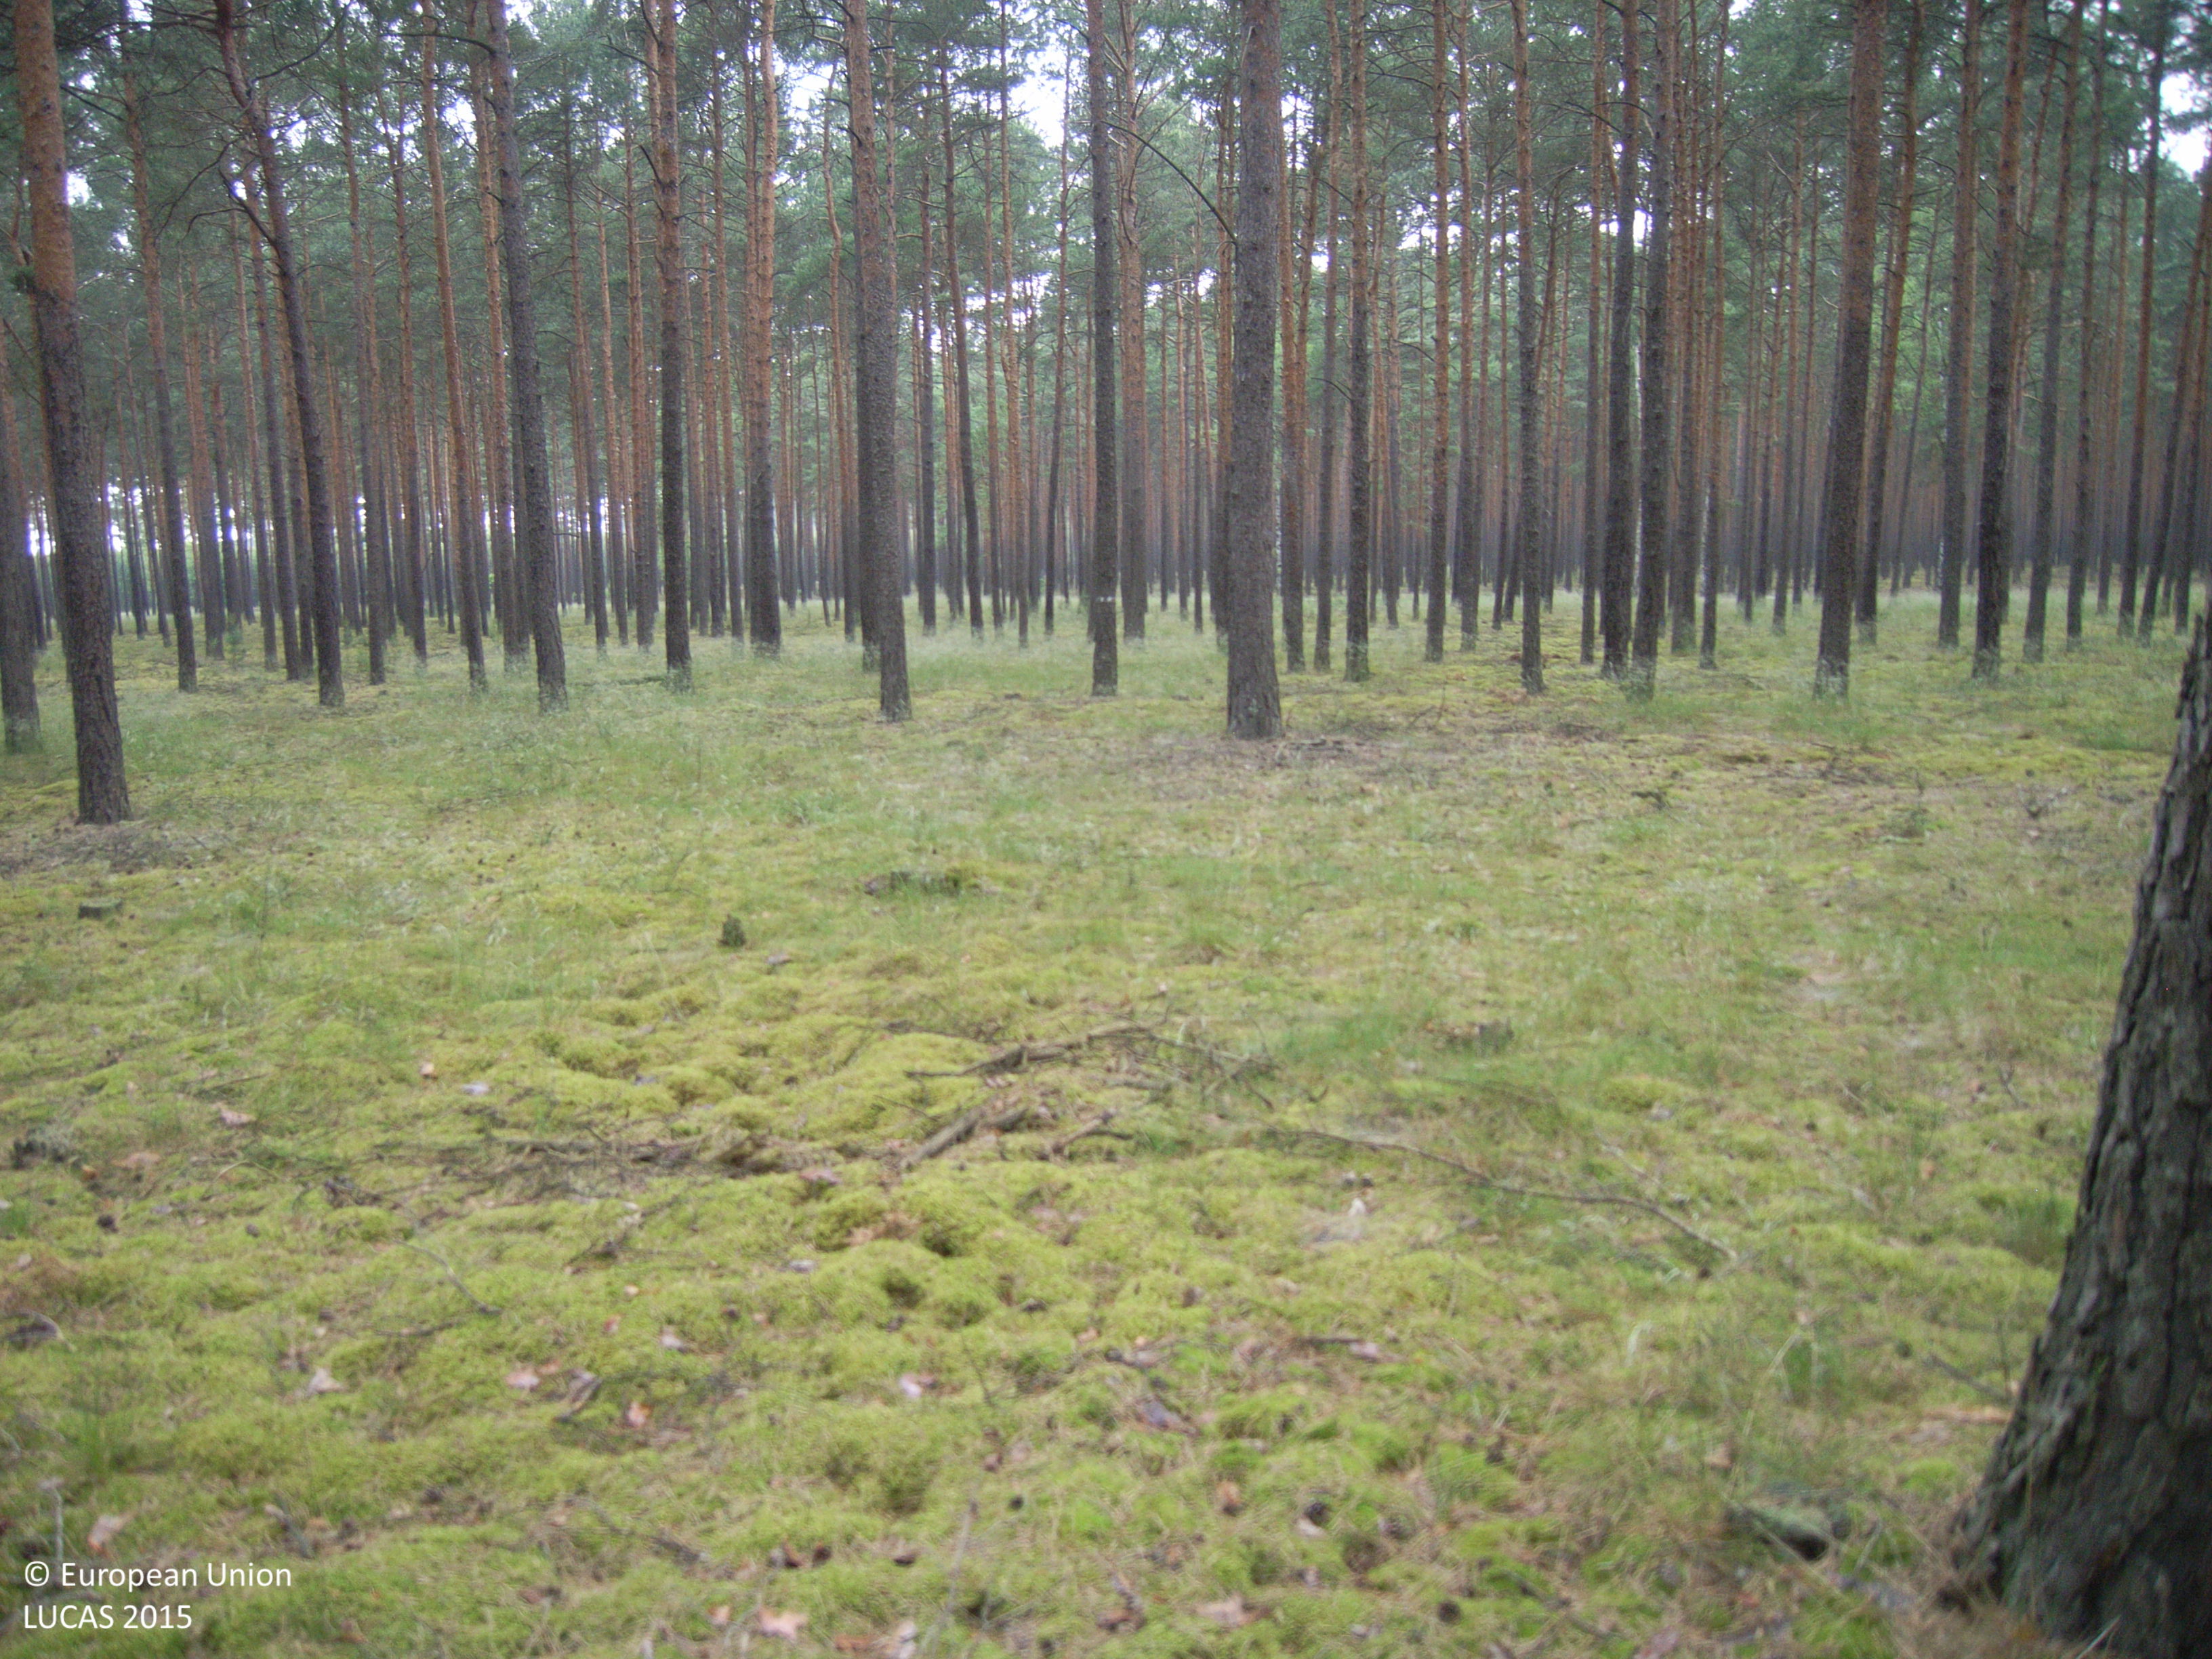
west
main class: Woodland
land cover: Pine dominated coniferous woodland
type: hemiboreal forest and nemoral coniferous forest and mixed broadleaved-coniferous forest
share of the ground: > 75 %
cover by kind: coniferous forest trees 100 %
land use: Forestry
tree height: > 5 m
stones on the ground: < 10 %
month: June
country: DE
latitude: 52.0443
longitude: 14.3902
